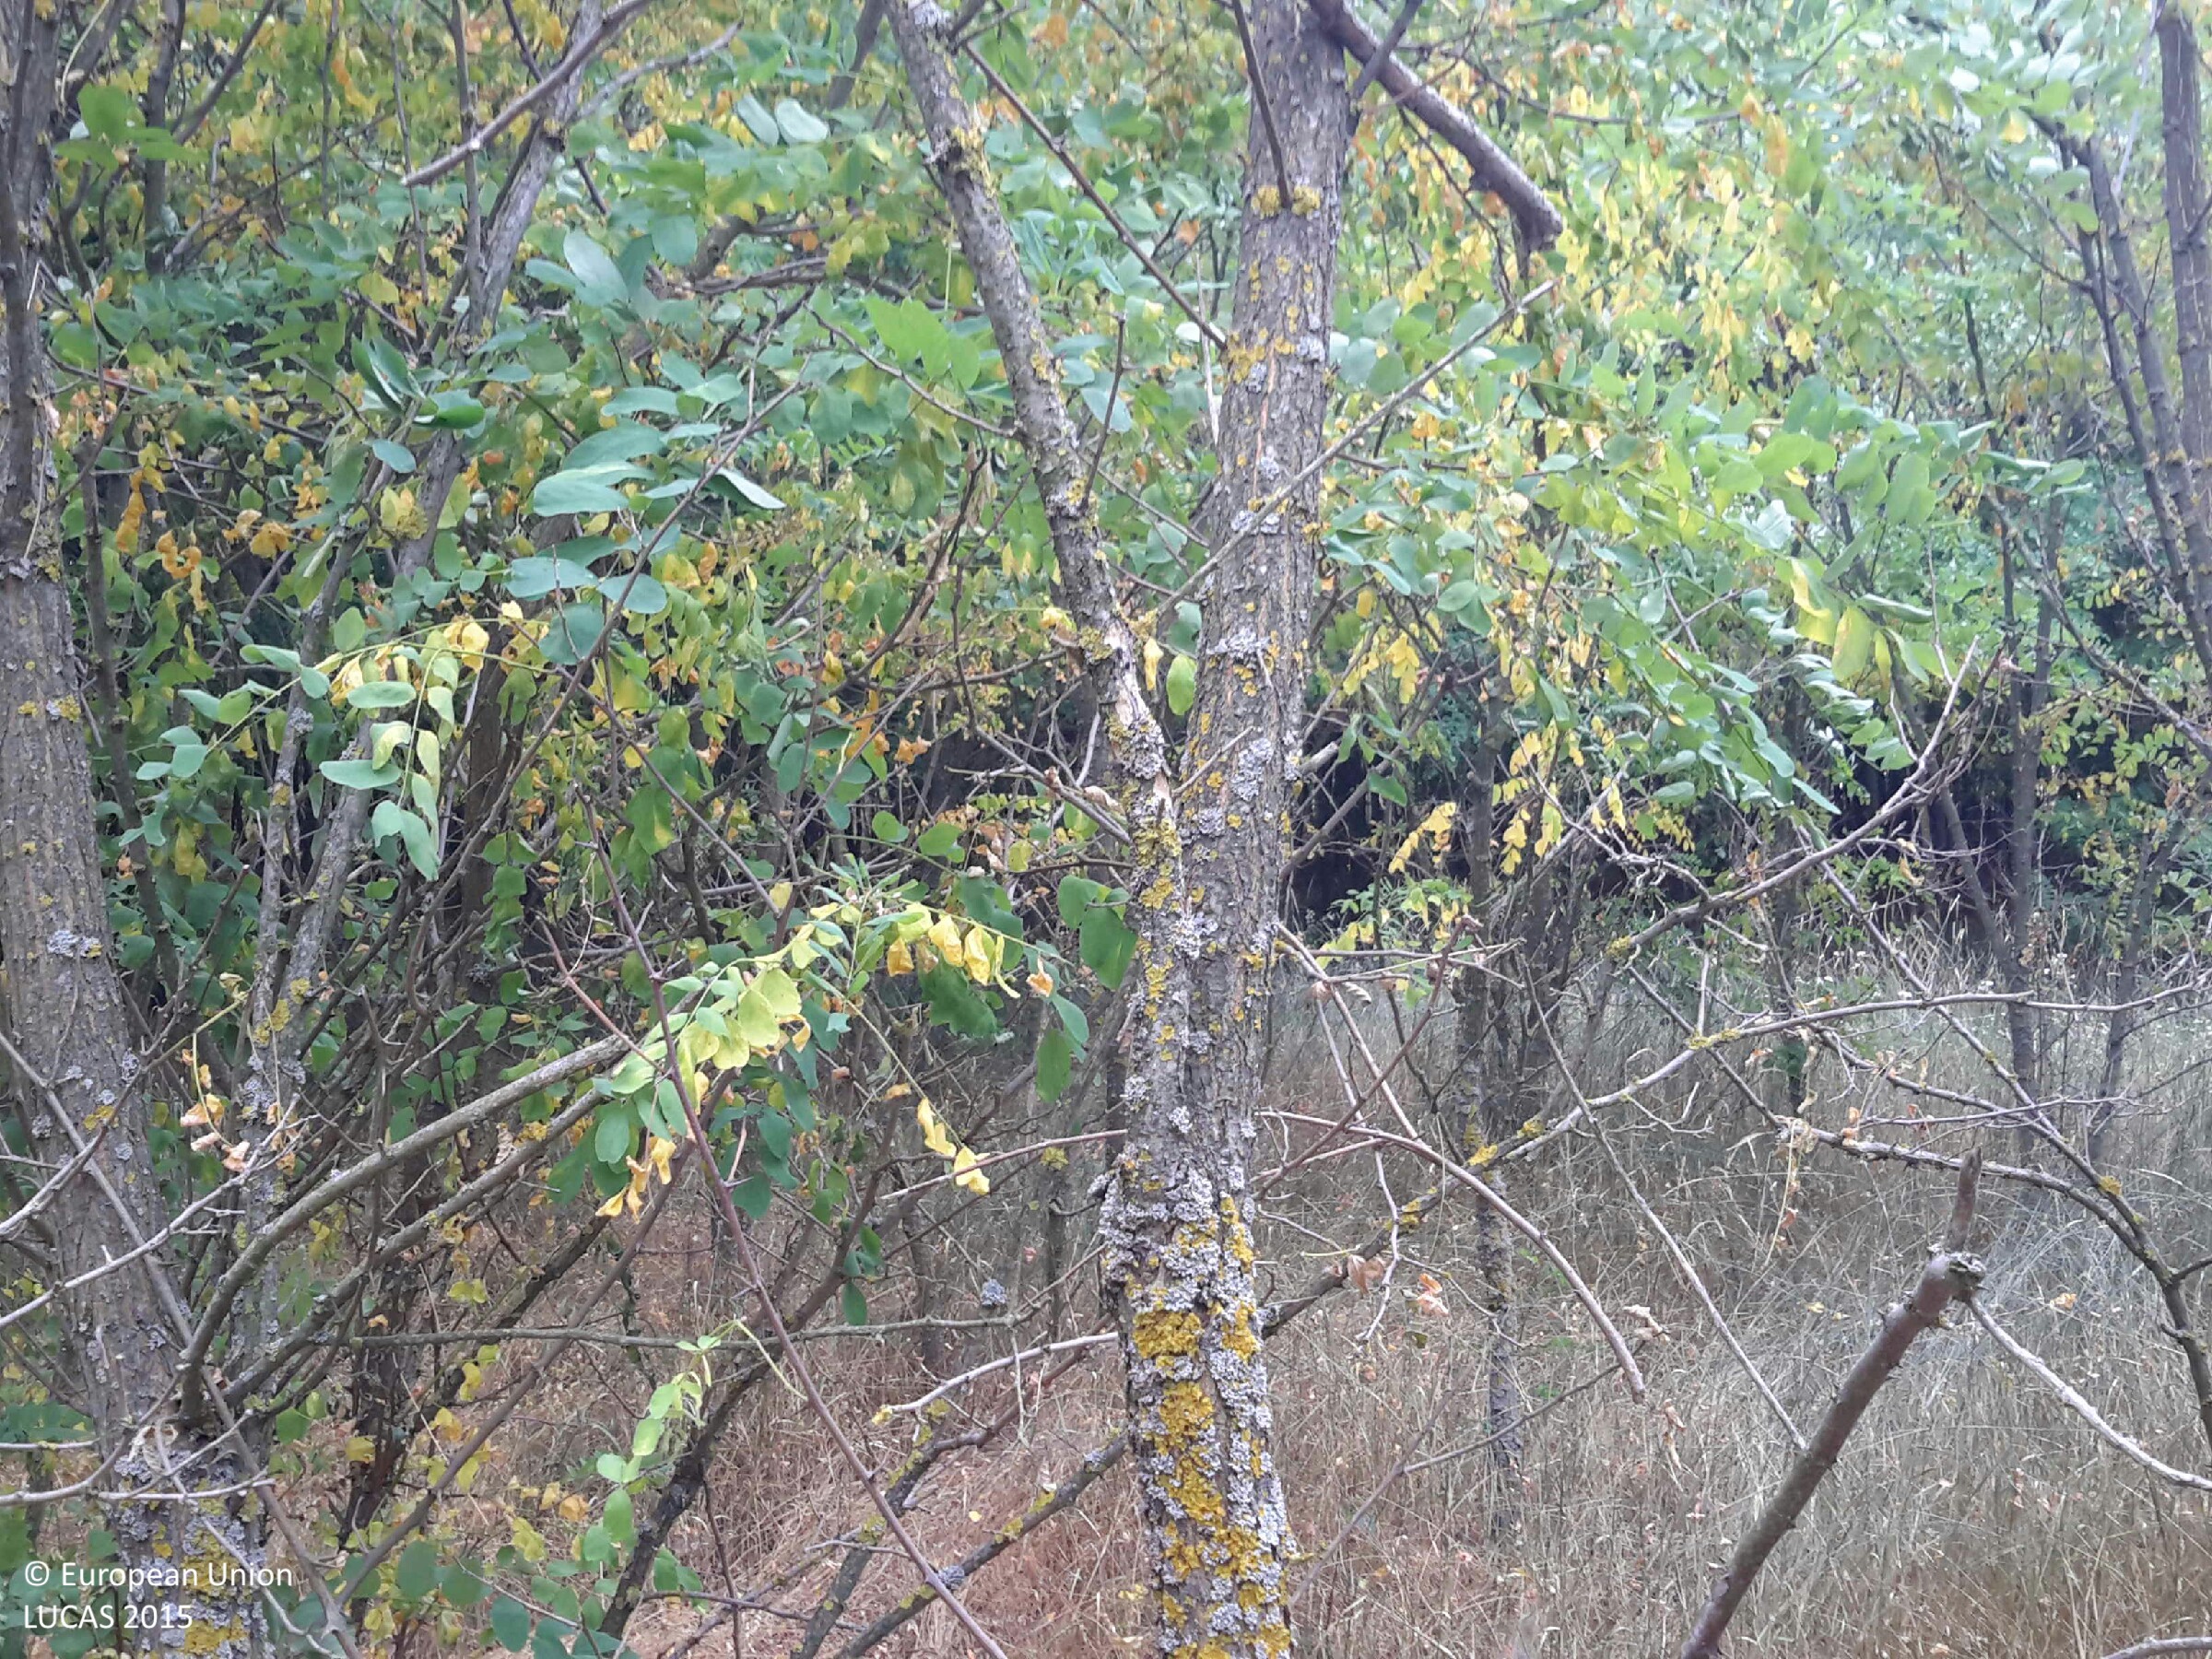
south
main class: Woodland
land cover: Broadleaved woodland
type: mesophytic deciduous forest
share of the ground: 50 - 75 %
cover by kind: broadleaved forest trees 70 %, herbaceous plants 30 %
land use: Forestry
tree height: > 5 m
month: July
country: HU
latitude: 47.4079
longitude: 17.2289
